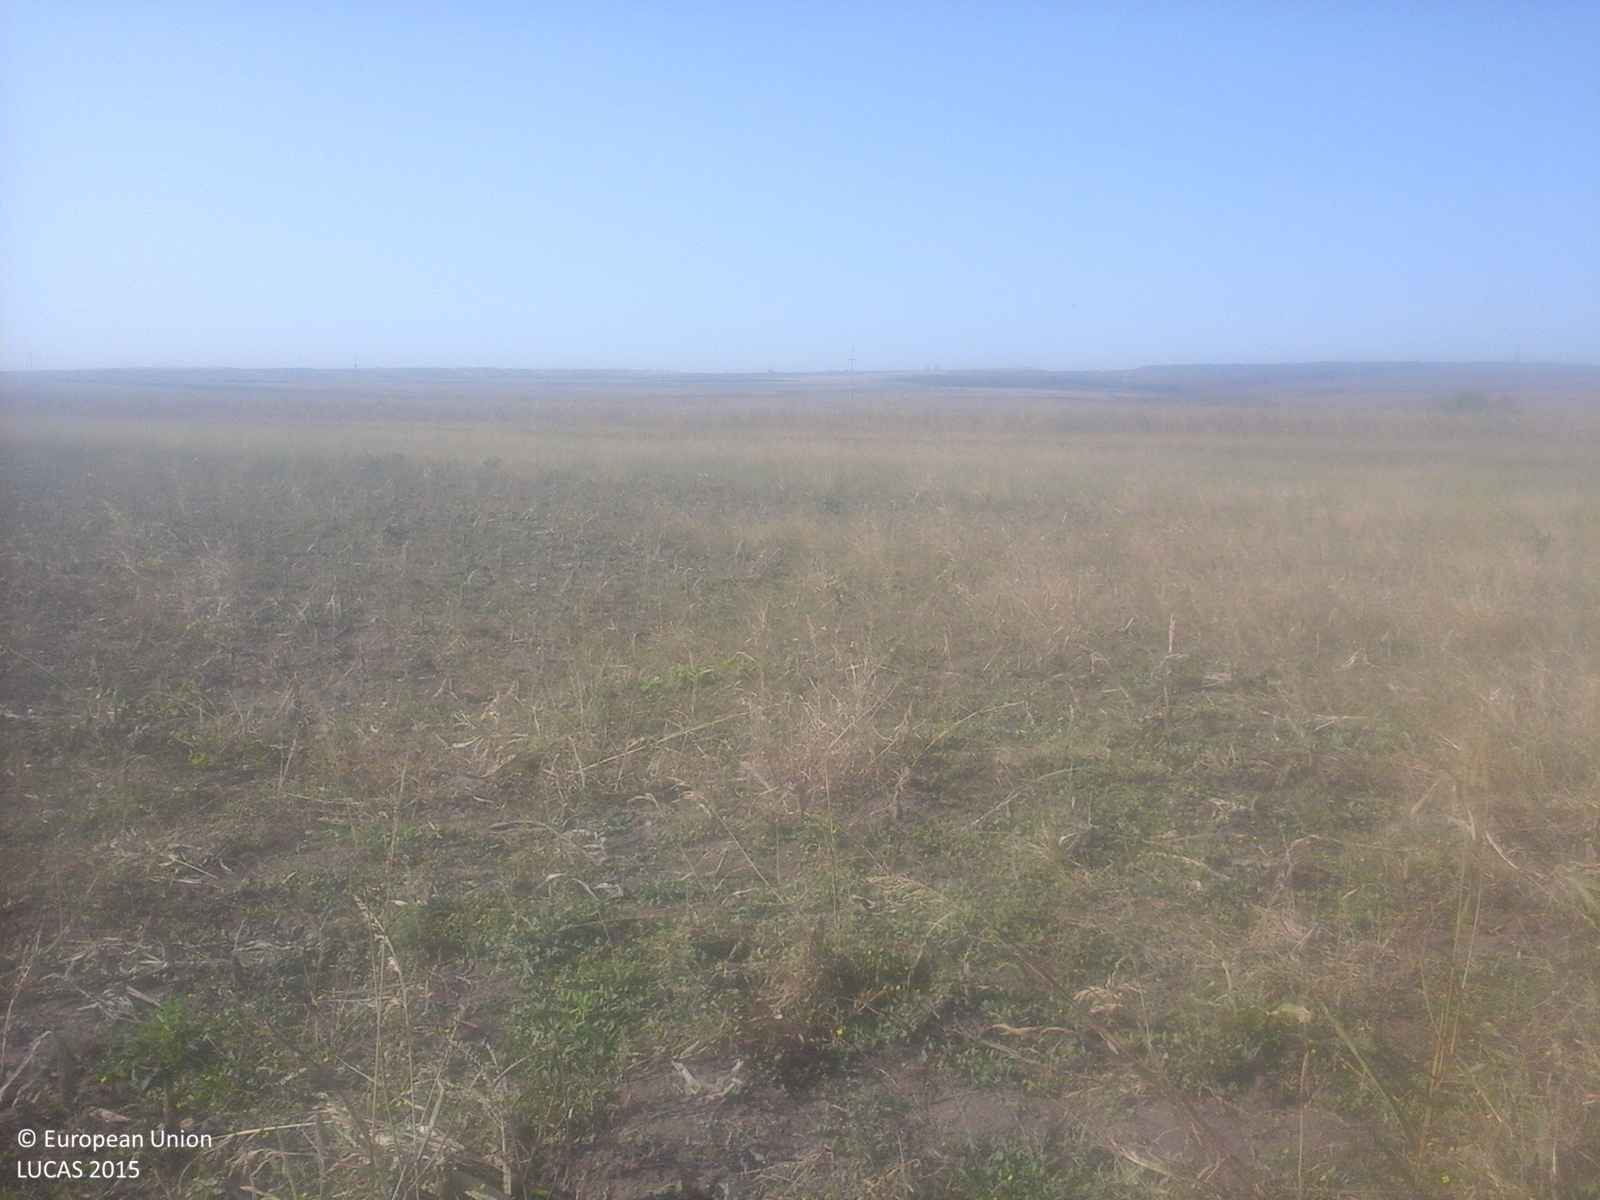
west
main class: Cropland
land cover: Maize
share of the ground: 10 - 25 %
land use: Agriculture (excluding fallow land and kitchen gardens)
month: October
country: RO
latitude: 45.3499
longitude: 26.9723
